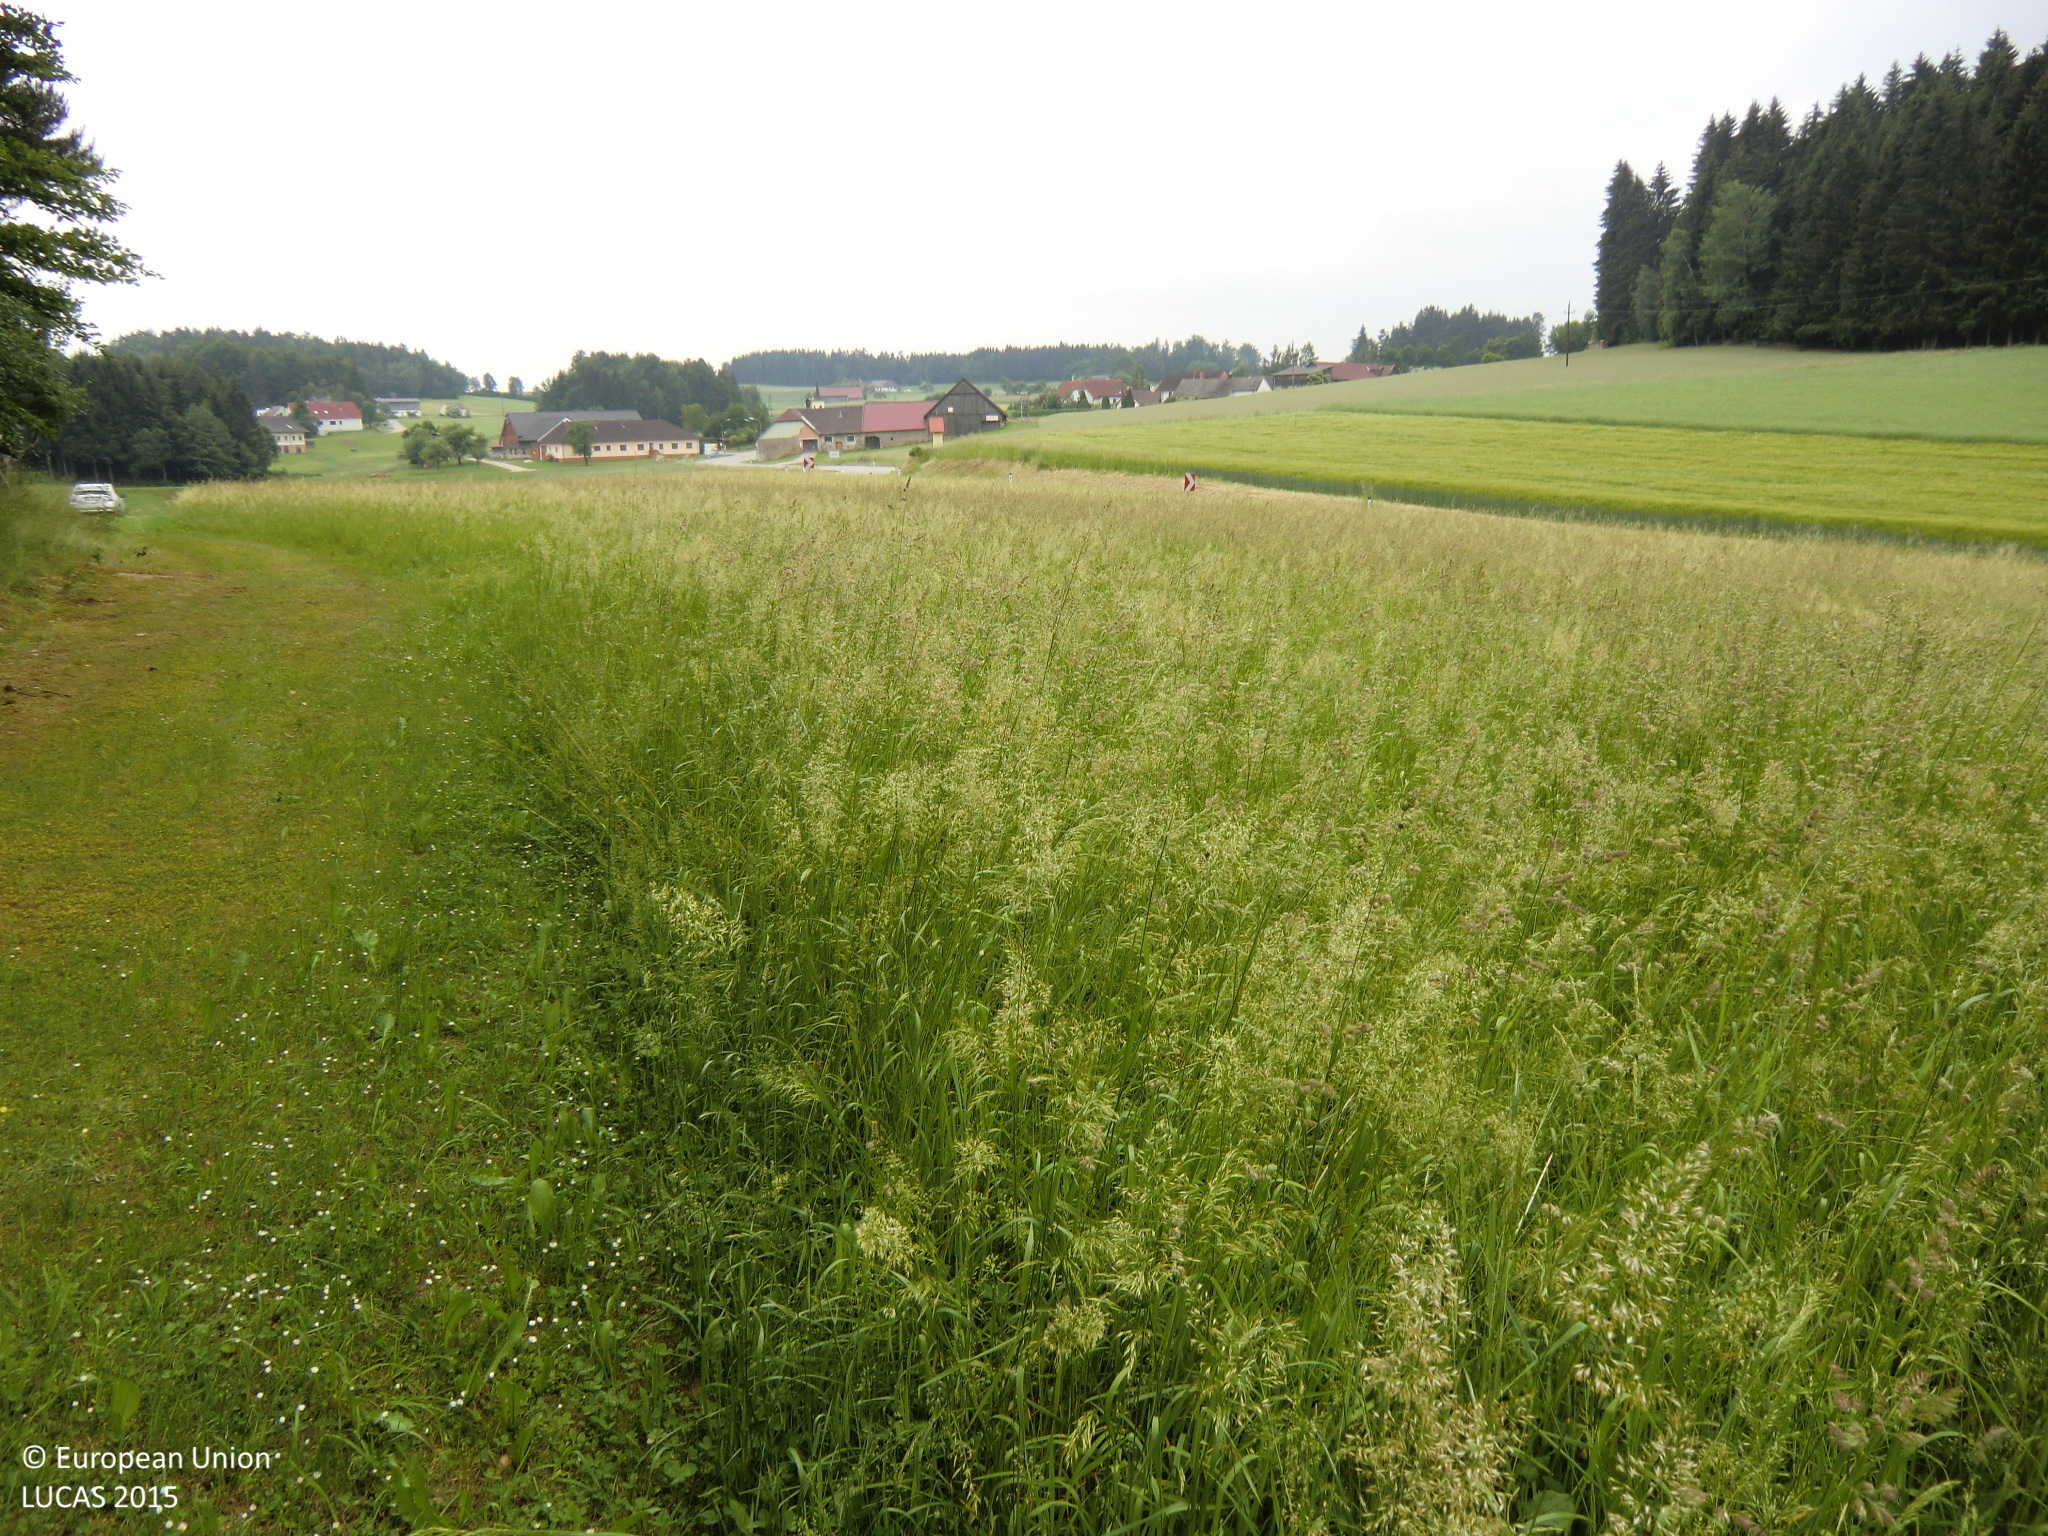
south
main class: Cropland
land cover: Temporary grasslands
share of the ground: > 75 %
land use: Agriculture (excluding fallow land and kitchen gardens)
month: June
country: AT
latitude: 48.5979
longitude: 14.9781
